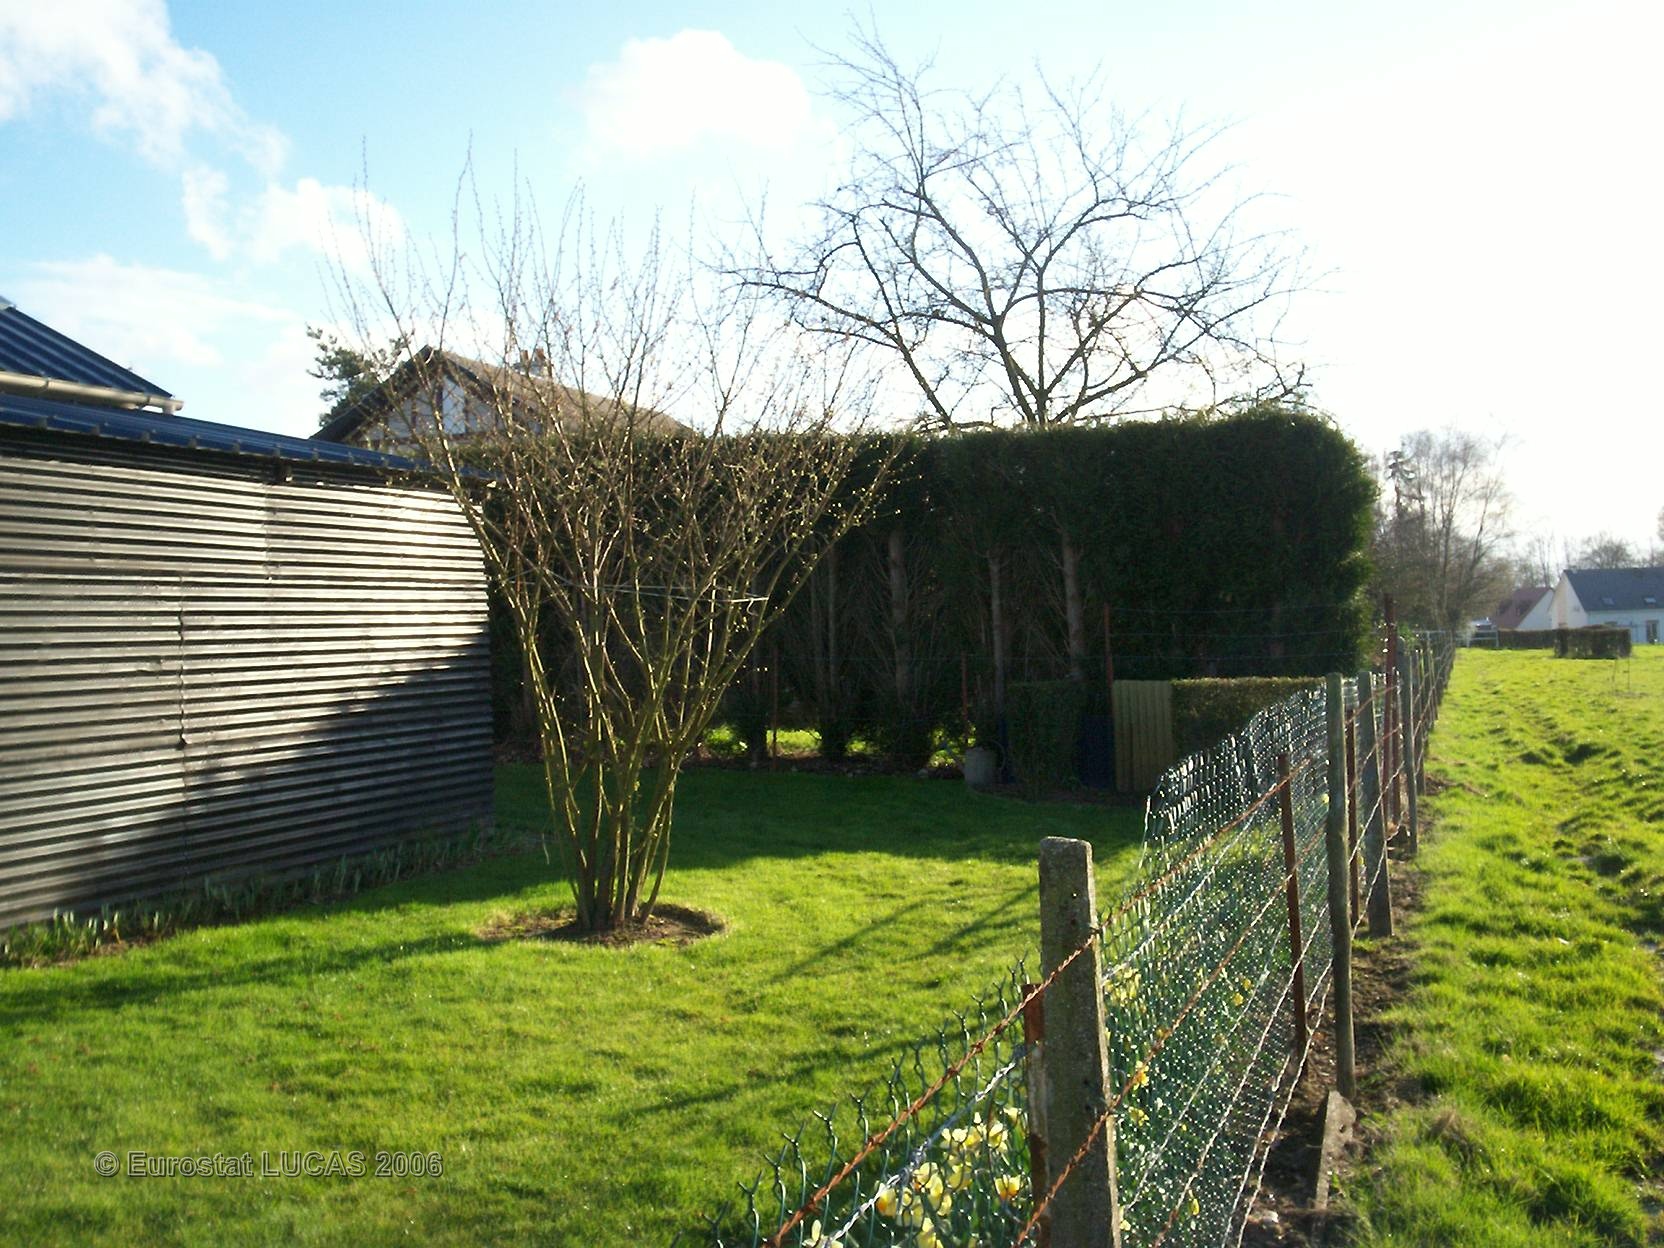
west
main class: Grassland
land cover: Grassland without tree/shrub cover
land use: Residential
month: April
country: FR
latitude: 49.5345
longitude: 0.9543
